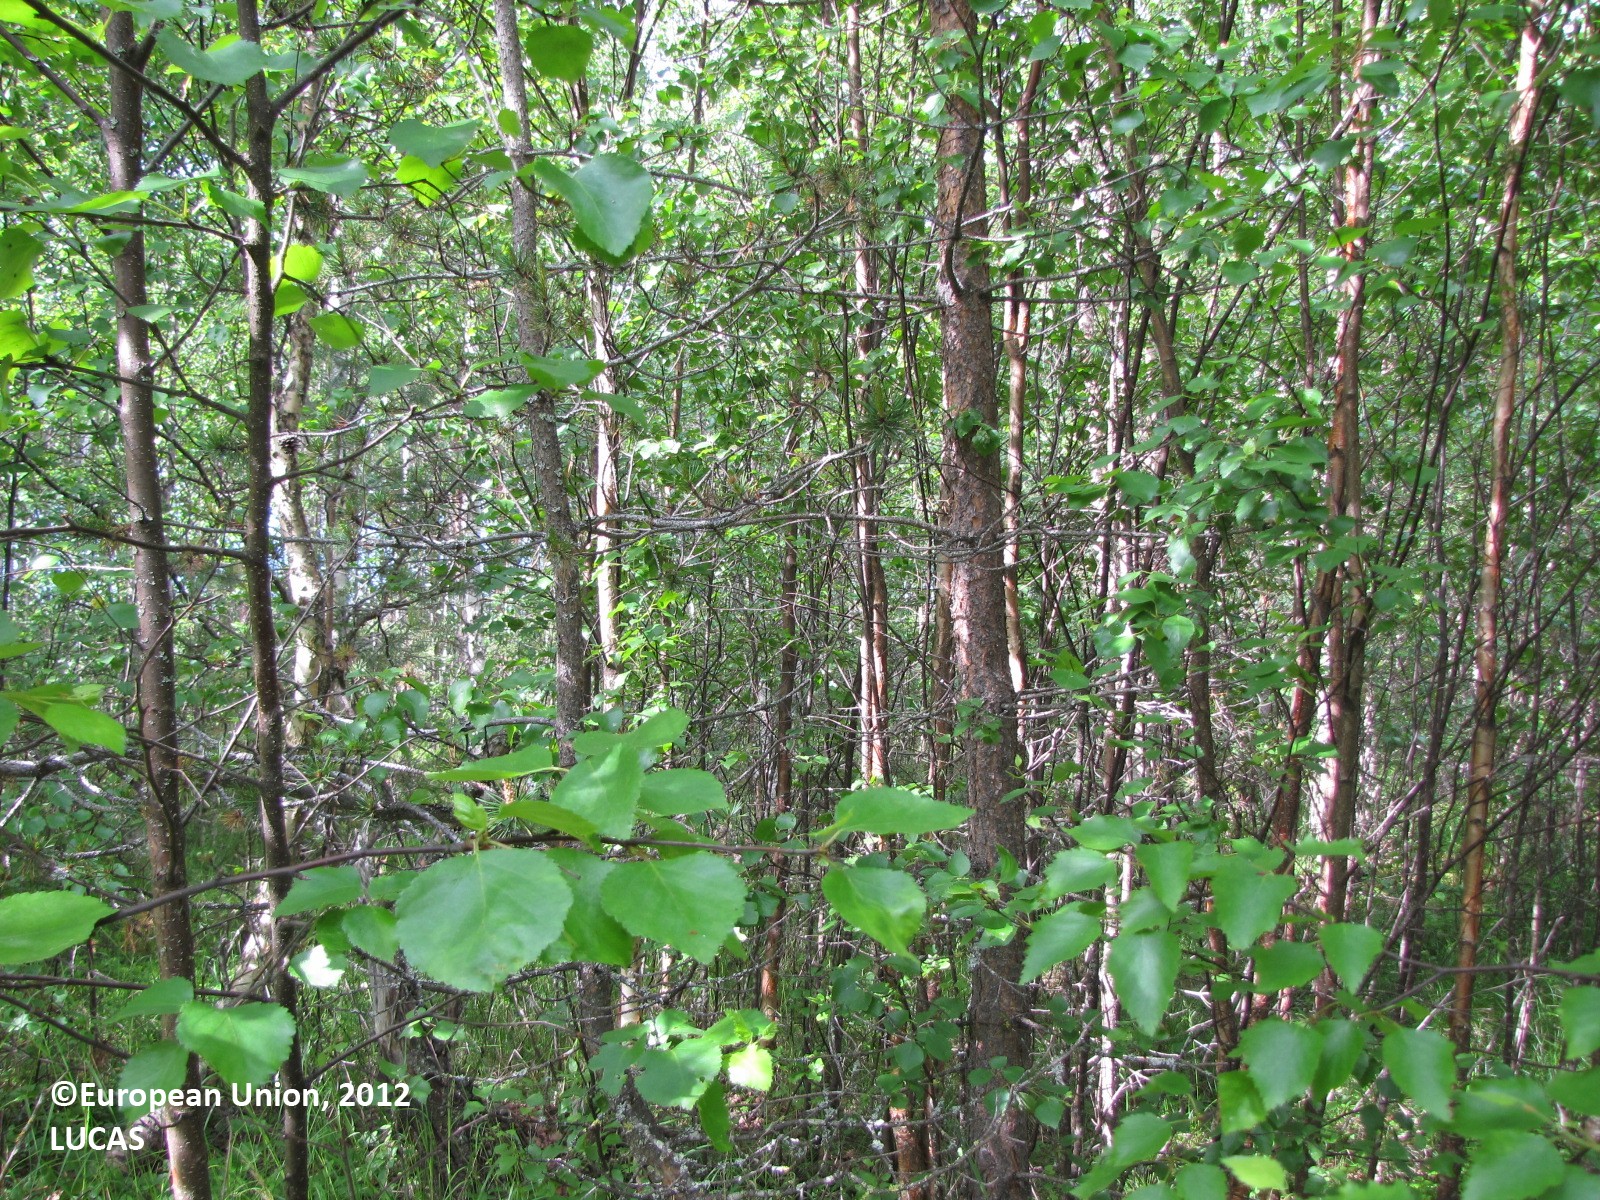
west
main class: Woodland
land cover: Broadleaved woodland
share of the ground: 50 - 75 %
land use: Forestry
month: July
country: FI
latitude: 66.1420
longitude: 25.1502
